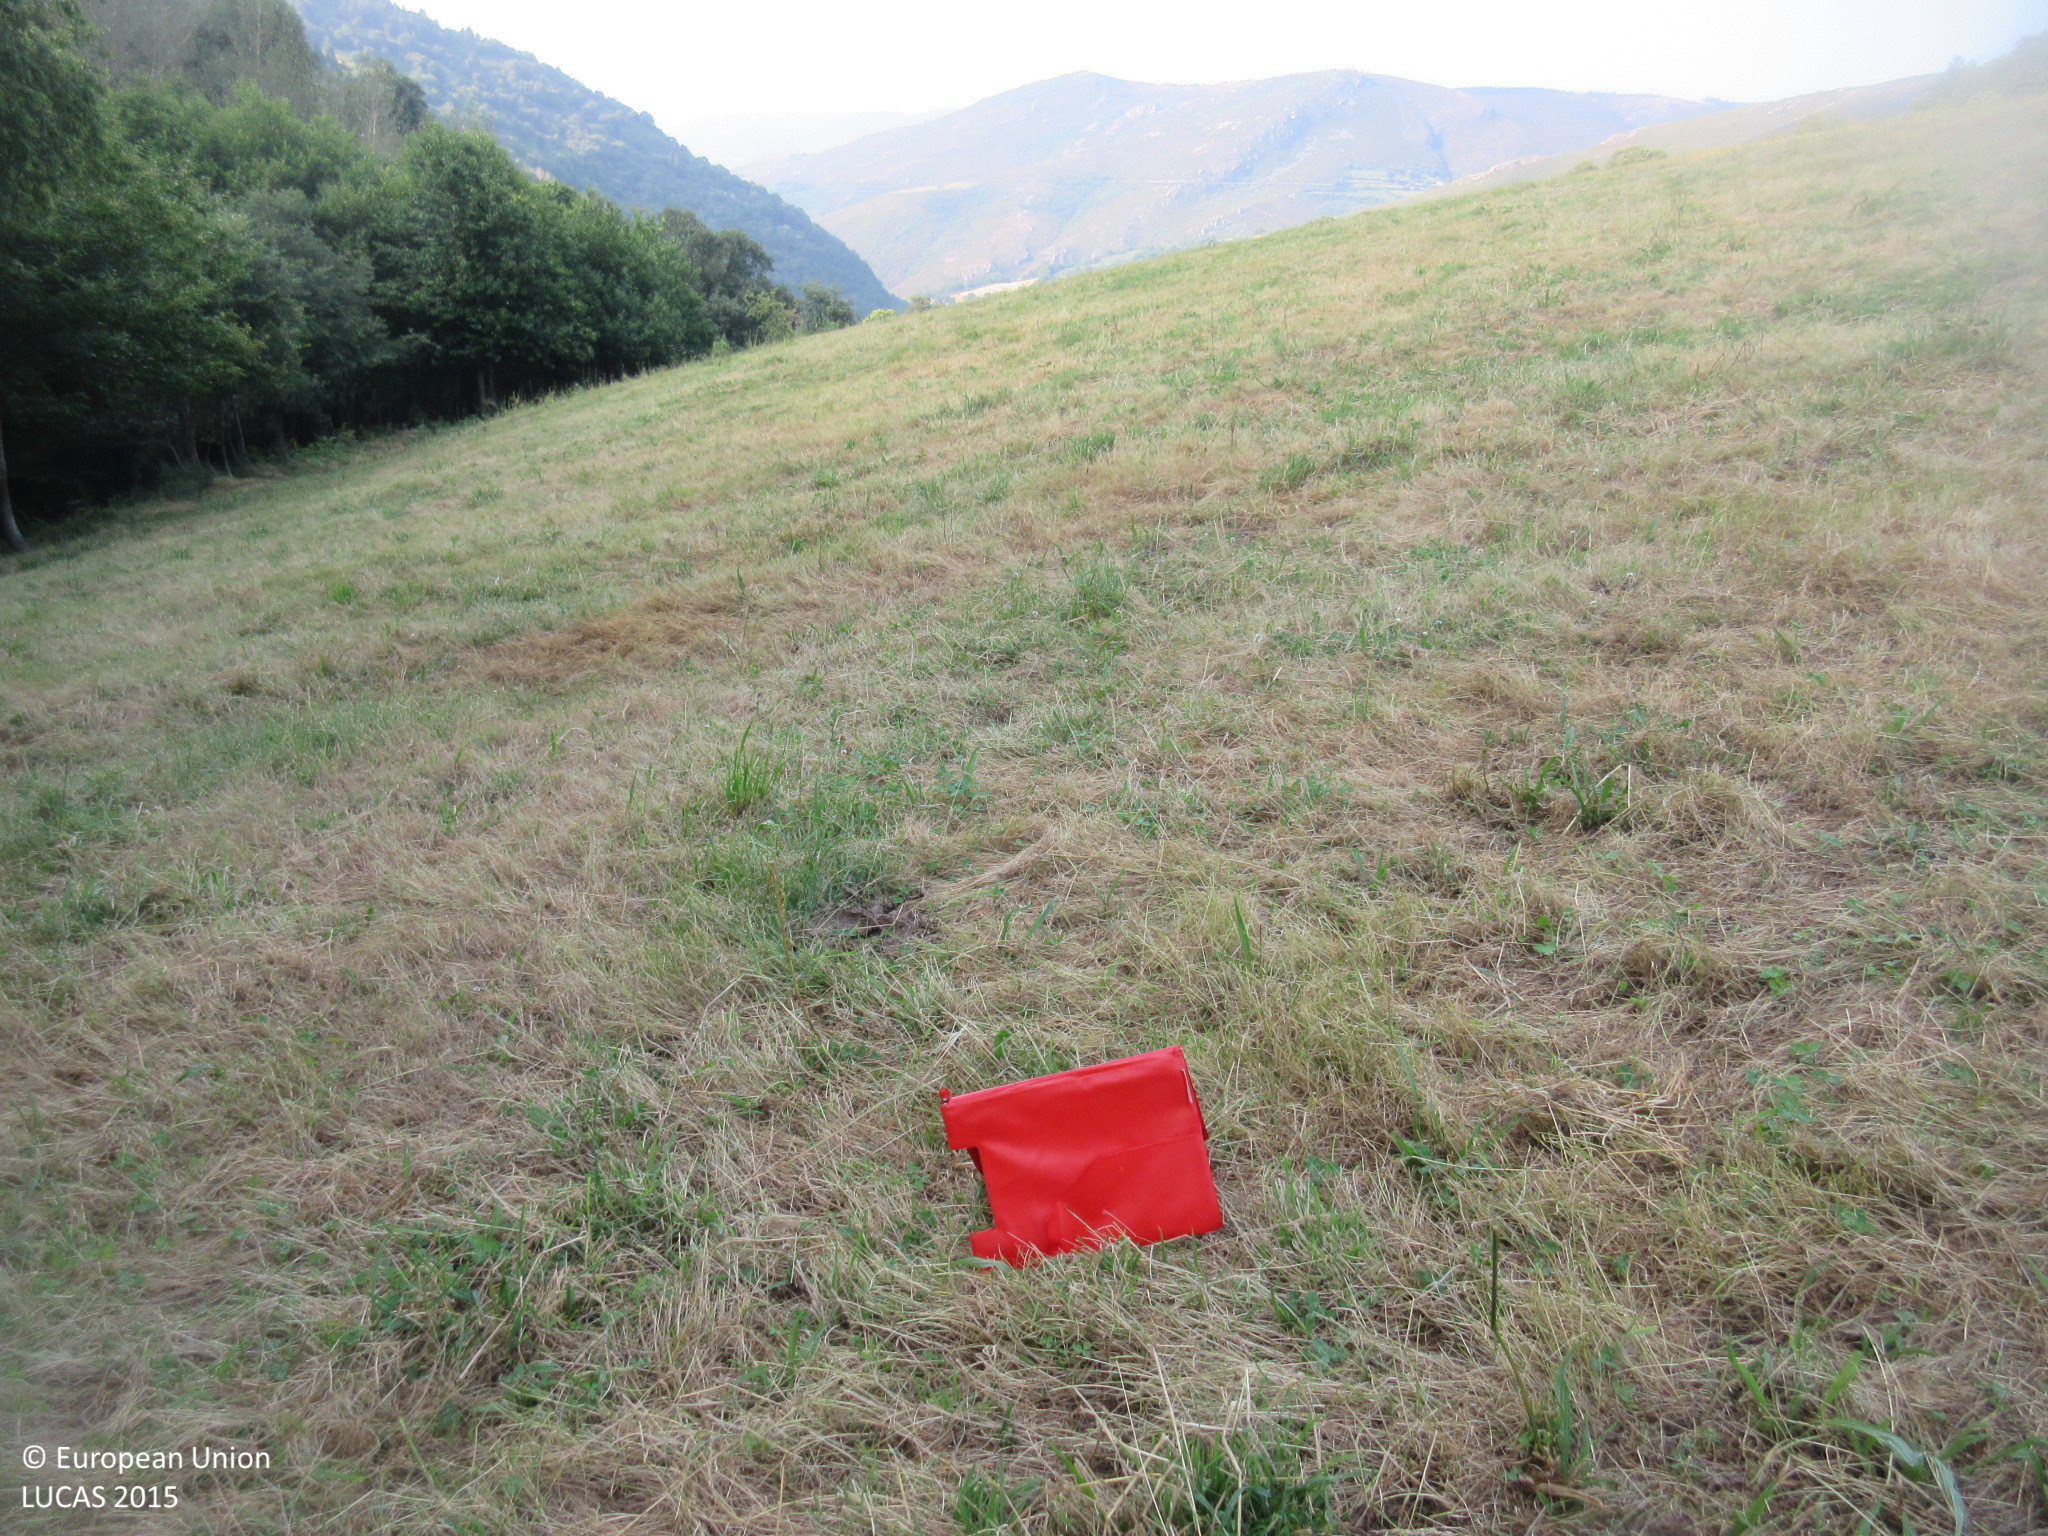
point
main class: Grassland
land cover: Grassland without tree/shrub cover
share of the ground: > 75 %
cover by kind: herbaceous plants 100 %
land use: Agriculture (excluding fallow land and kitchen gardens)
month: June
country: ES
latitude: 42.9379
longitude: -6.9843
